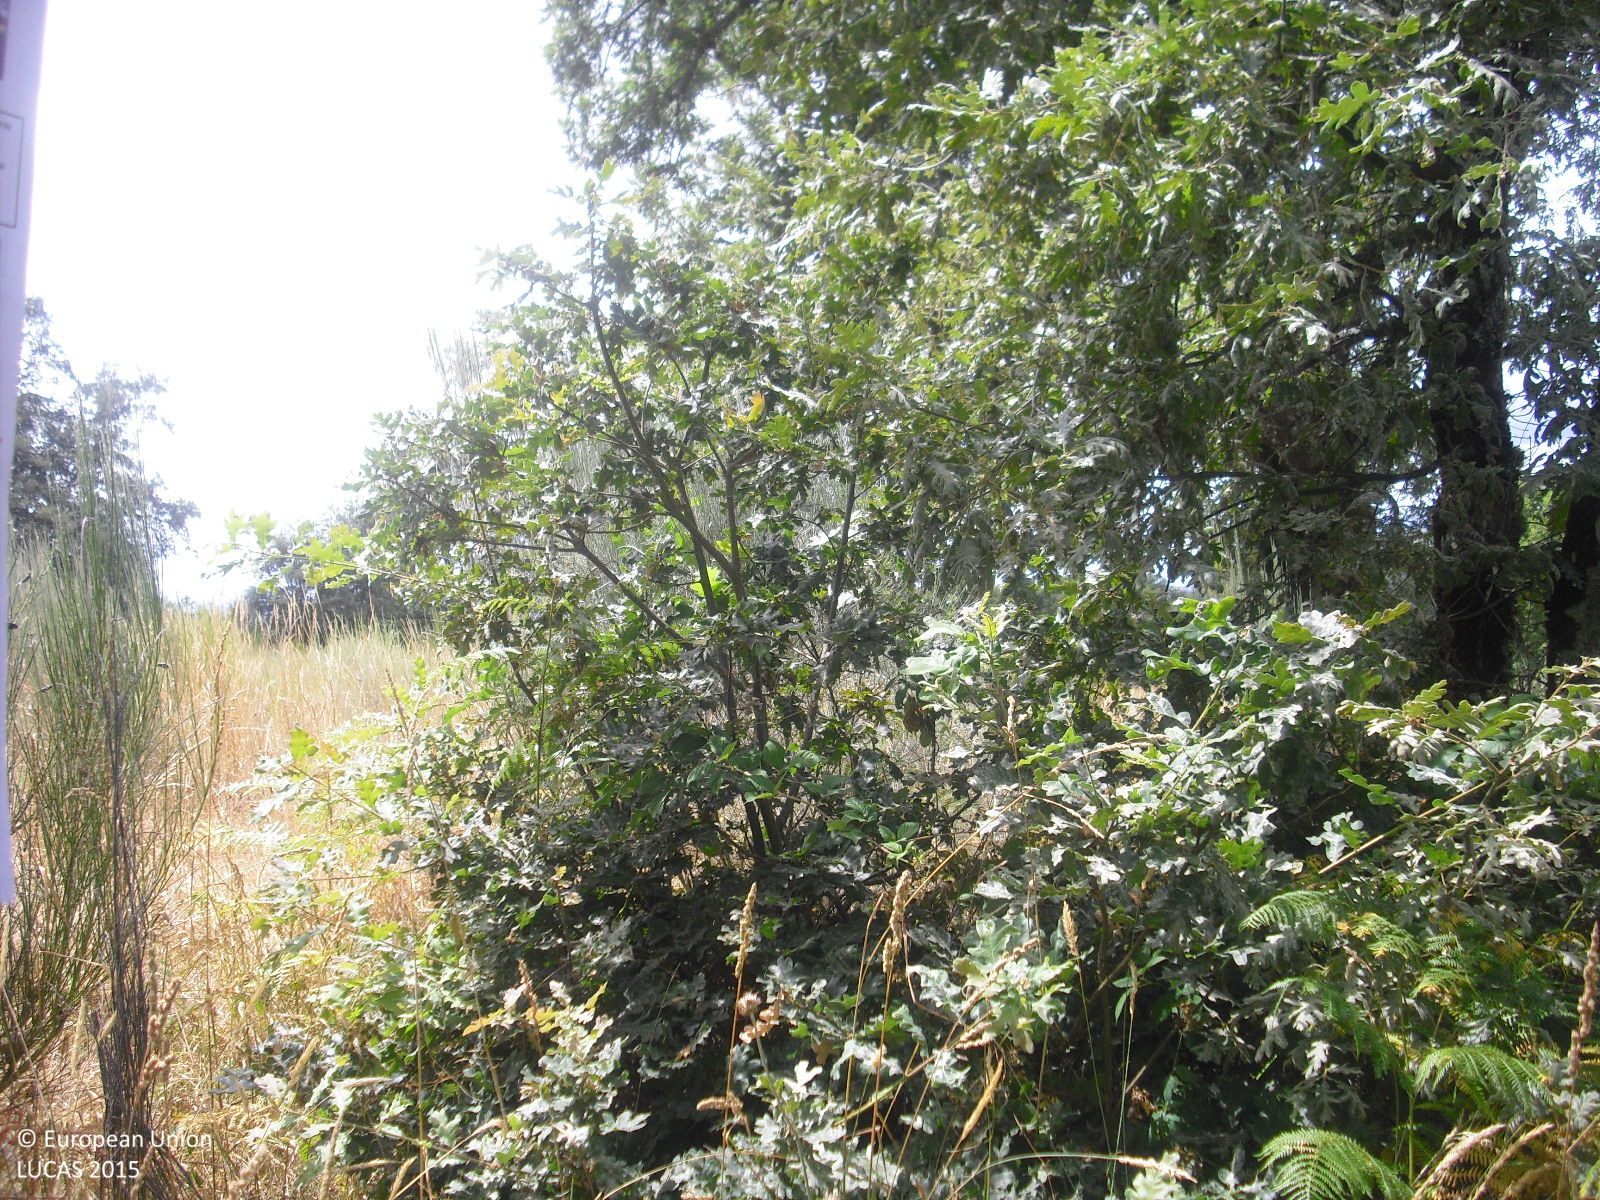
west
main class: Woodland
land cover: Broadleaved woodland
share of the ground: 25 - 50 %
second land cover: Shrubland without tree cover
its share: 50 - 75 %
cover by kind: broadleaved forest trees 50 %, shrubs 50 %
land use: Forestry
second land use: Agriculture (excluding fallow land and kitchen gardens)
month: July
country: ES
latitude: 42.3270
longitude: -7.4303
